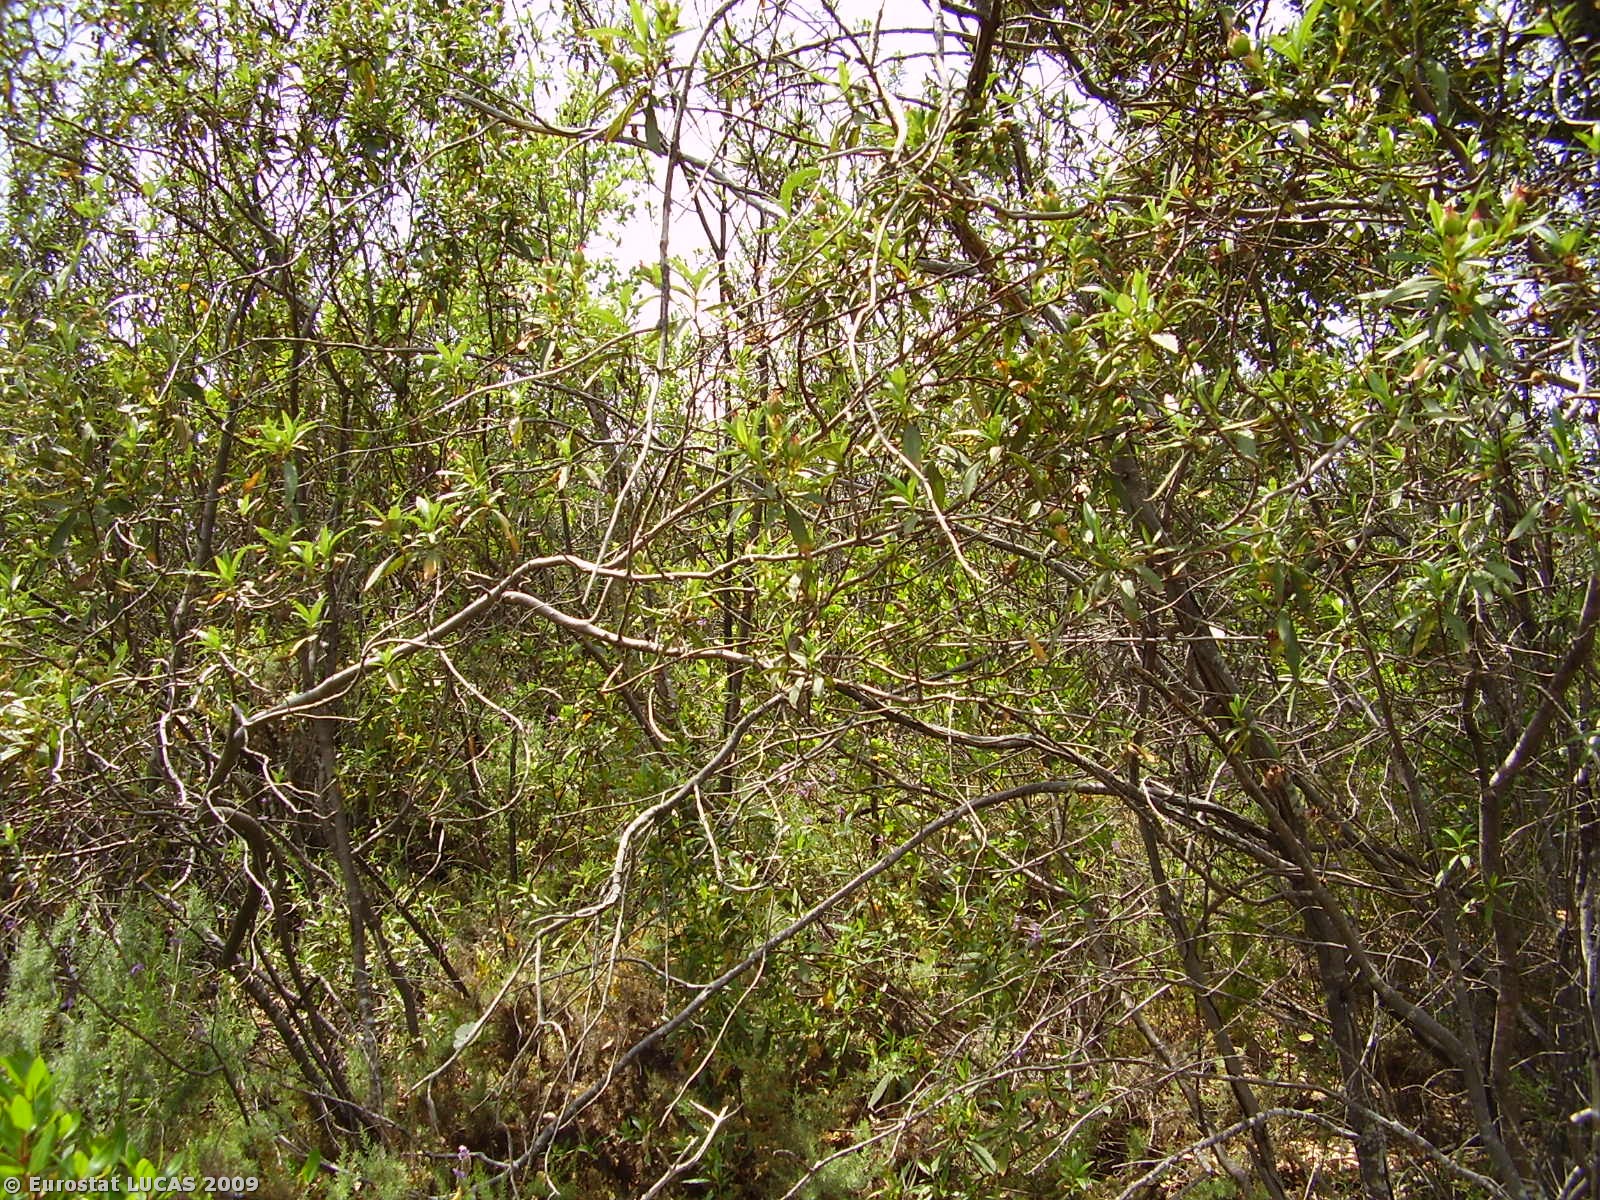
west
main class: Shrubland
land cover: Shrubland with sparse tree cover
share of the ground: > 75 %
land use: Fallow land
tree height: > 5 m
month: May
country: PT
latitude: 37.4149
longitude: -8.2261
